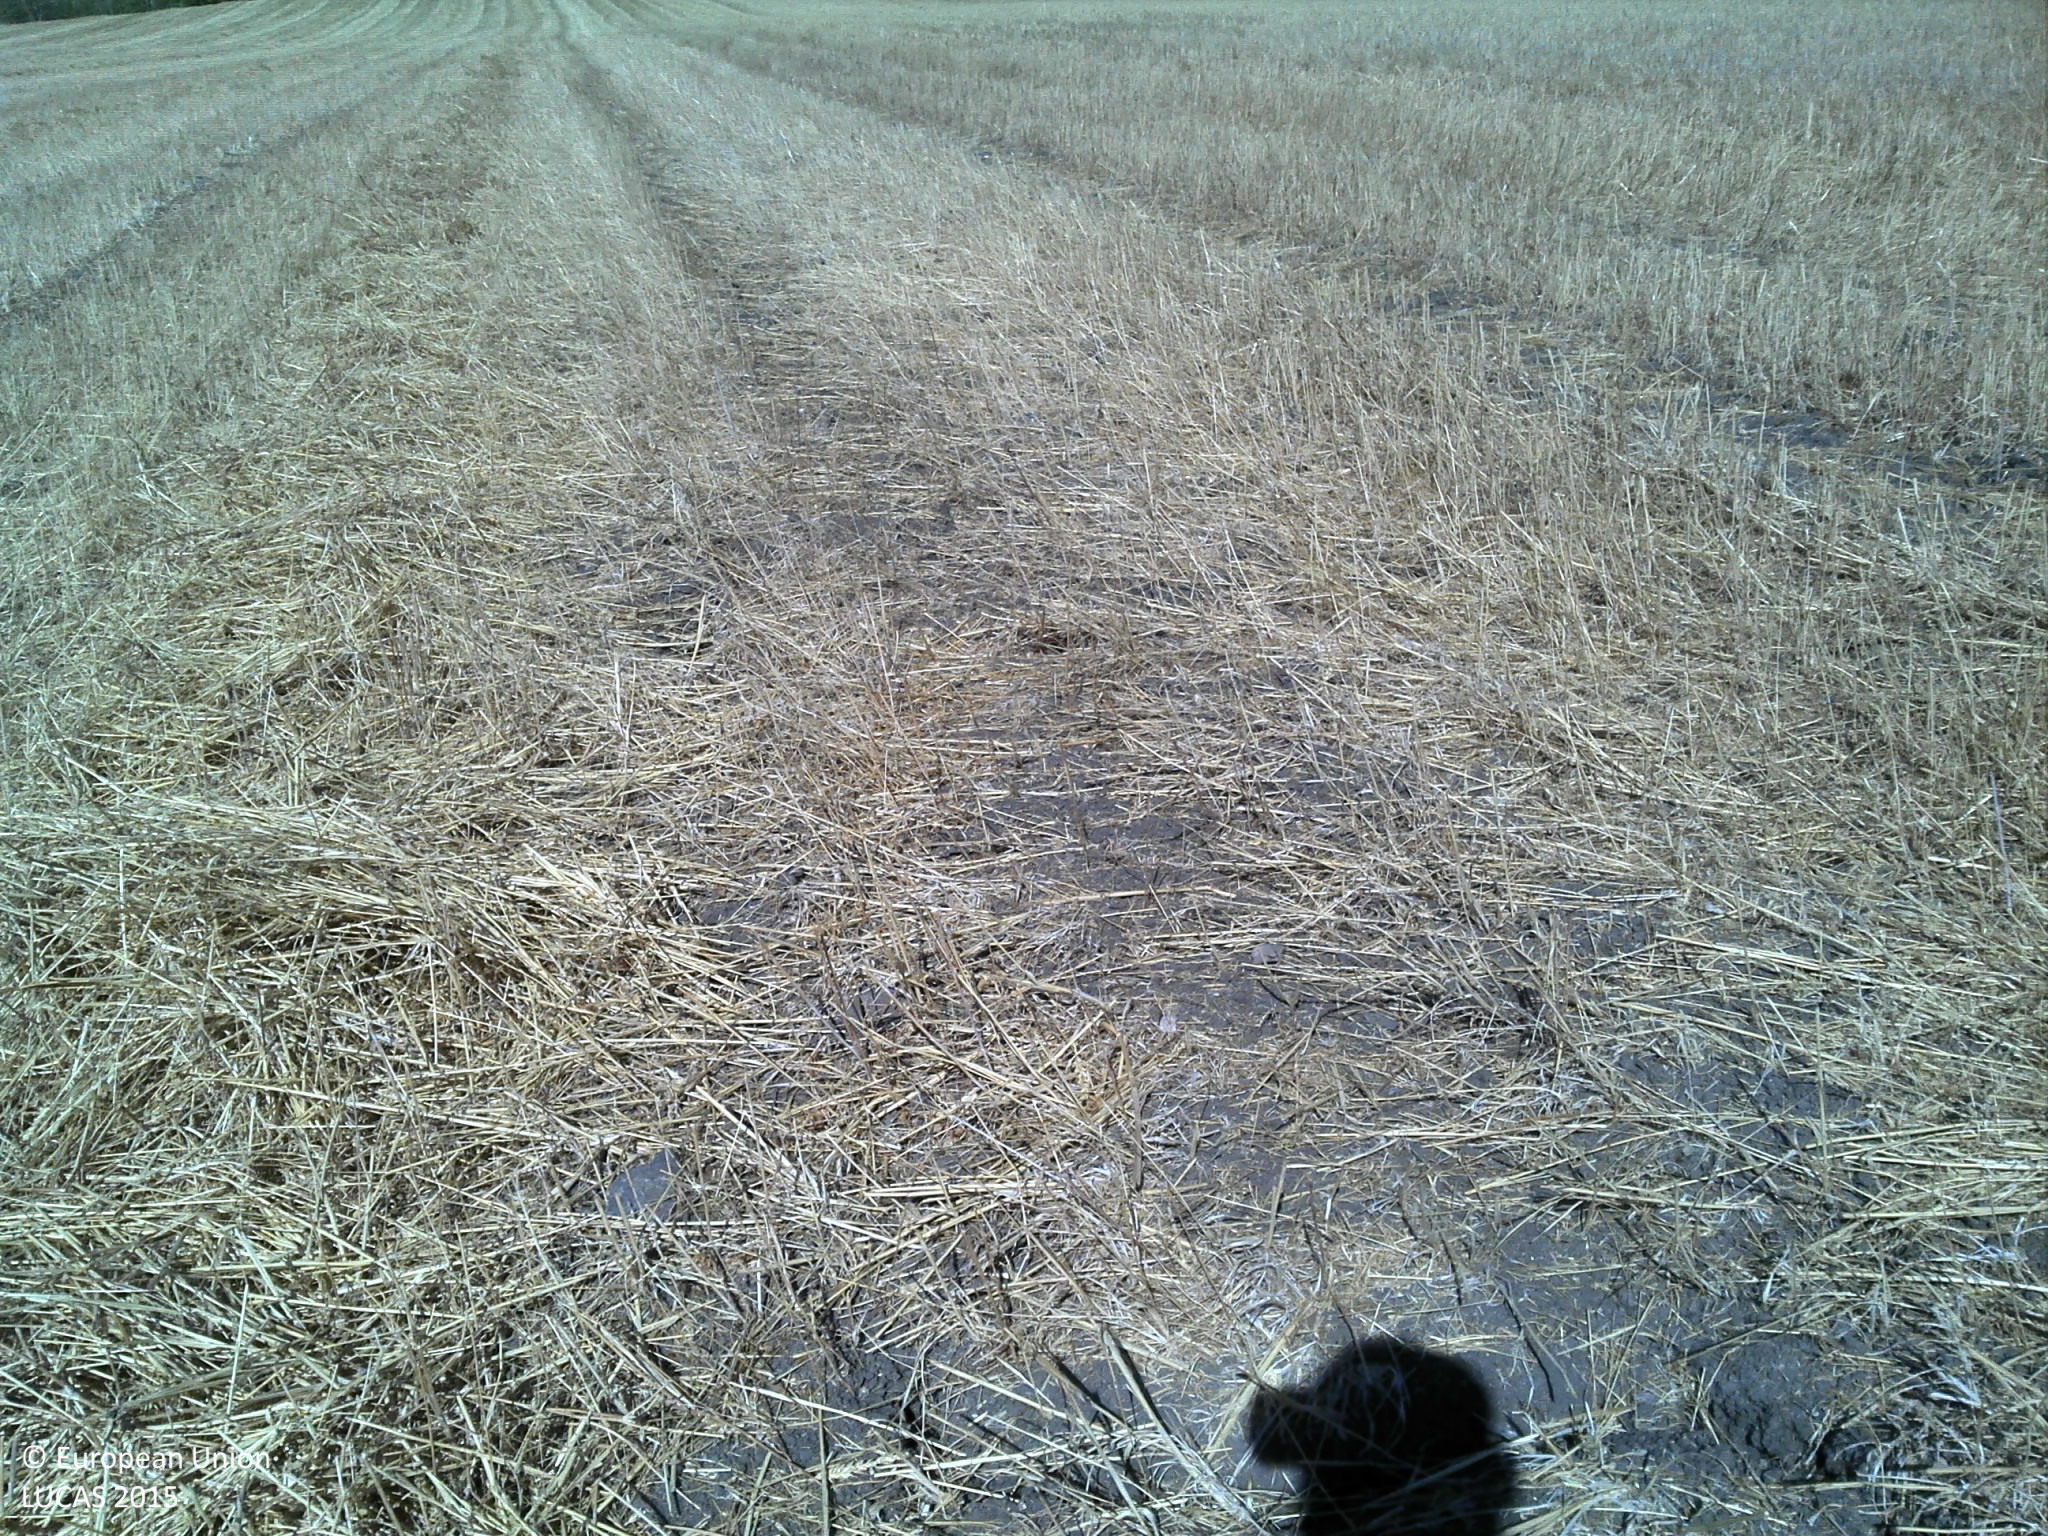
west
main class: Cropland
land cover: Common wheat
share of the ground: > 75 %
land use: Agriculture (excluding fallow land and kitchen gardens)
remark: Harvested field
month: August
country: PT
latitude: 37.9876
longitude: -7.8459
